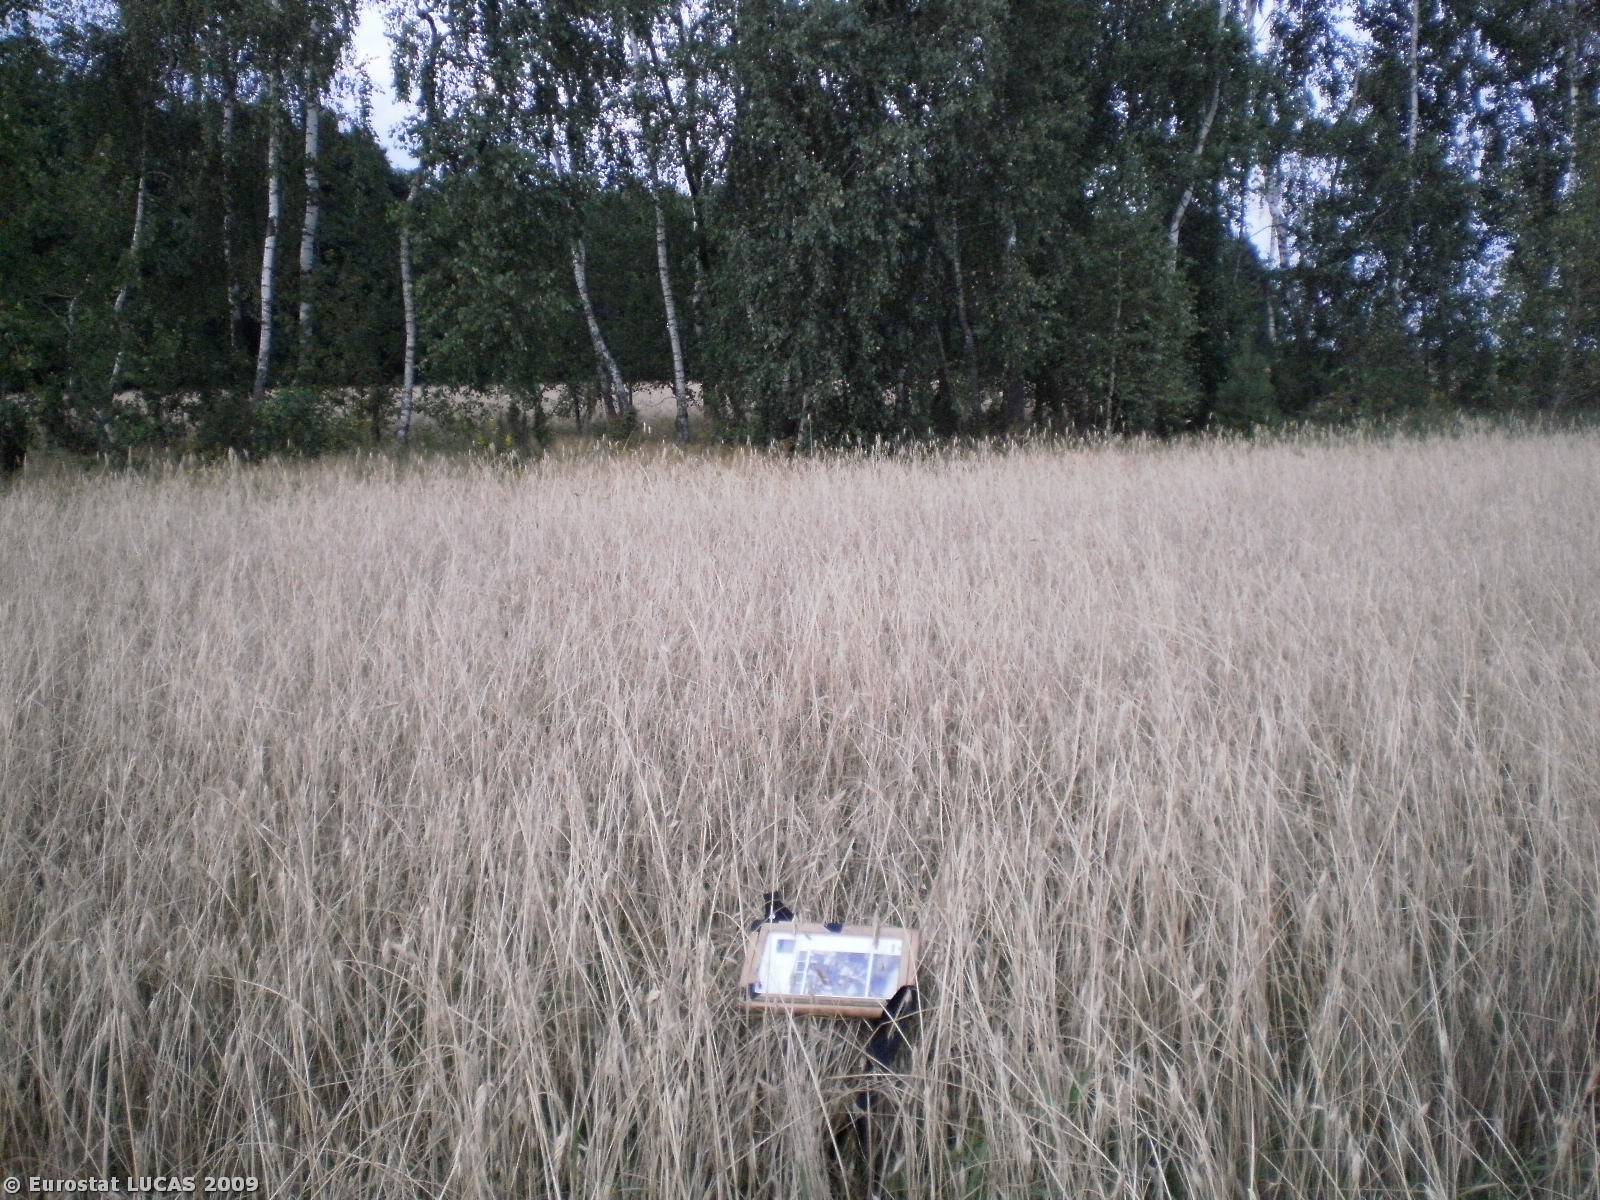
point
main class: Cropland
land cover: Rye
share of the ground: > 75 %
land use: Agriculture (excluding fallow land and kitchen gardens)
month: August
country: PL
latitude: 53.0797
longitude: 21.7730
